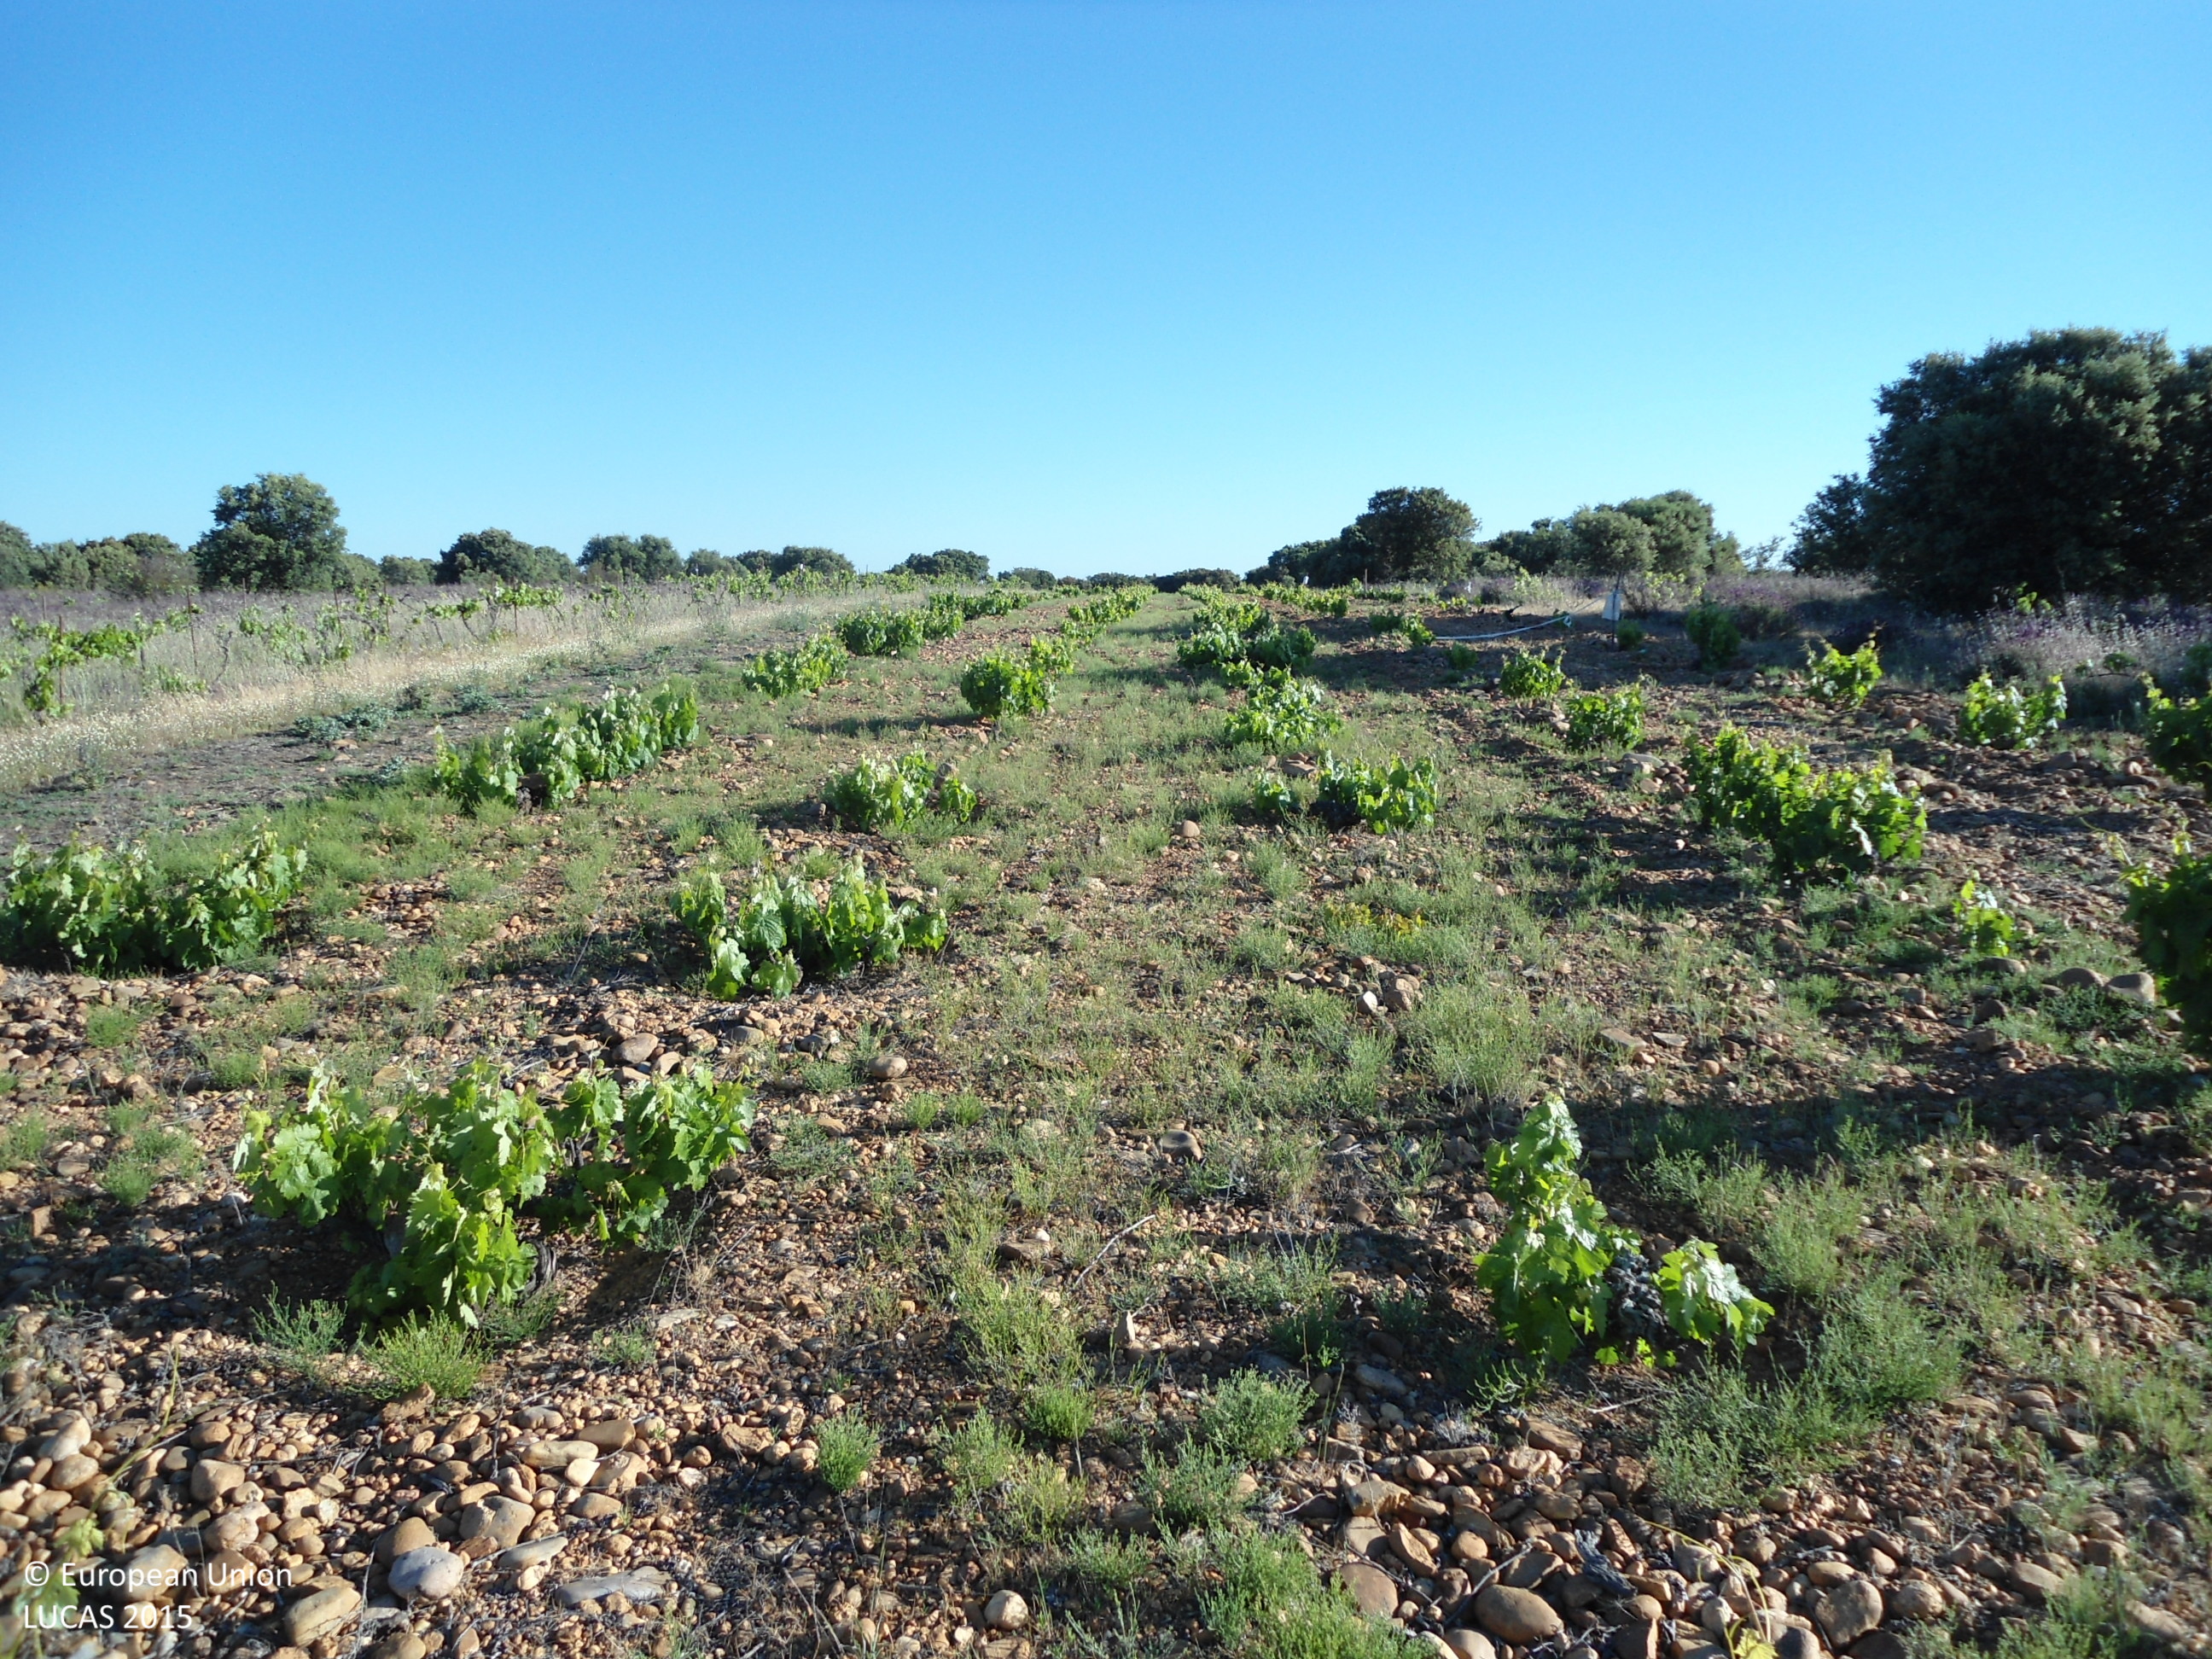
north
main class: Cropland
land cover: Vineyards
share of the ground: 25 - 50 %
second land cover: Other bare soil
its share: > 75 %
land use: Agriculture (excluding fallow land and kitchen gardens)
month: May
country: ES
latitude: 42.0090
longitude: -5.9268
